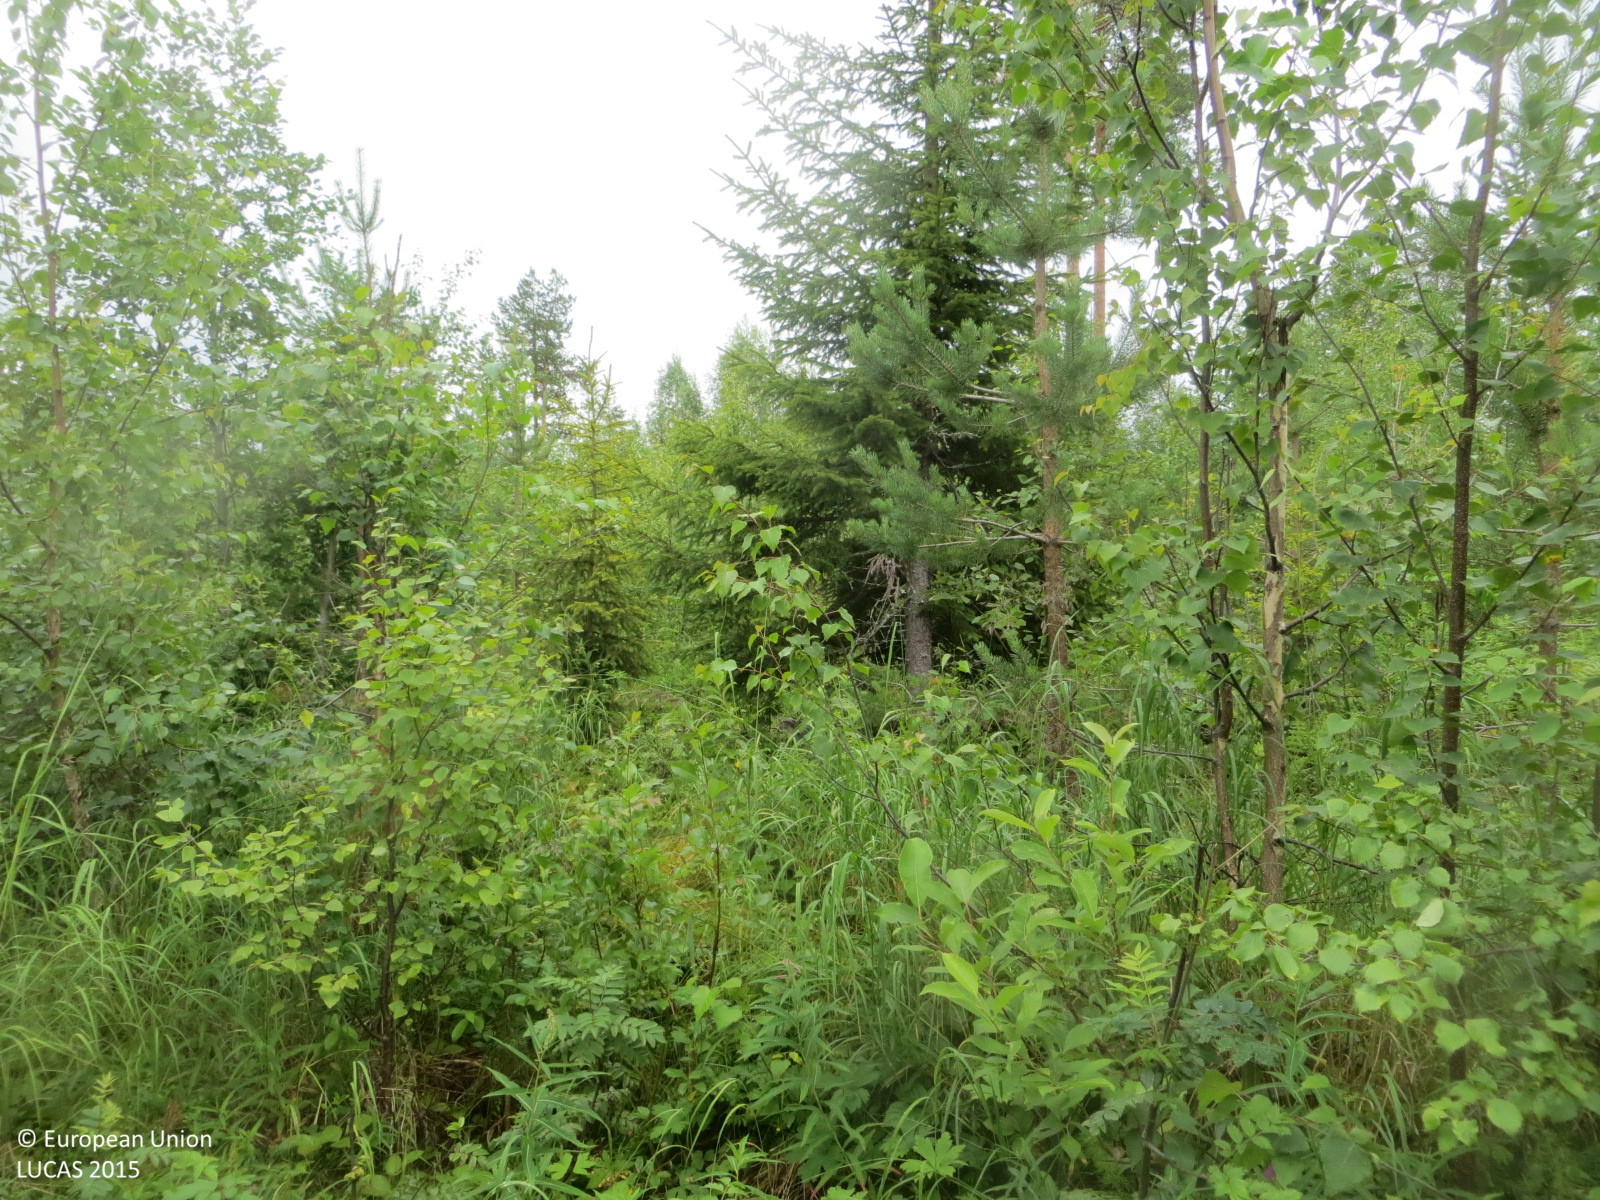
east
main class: Woodland
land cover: Other mixed woodland
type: boreal forest
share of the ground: > 75 %
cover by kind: broadleaved forest trees 50 %, coniferous forest trees 30 %, herbaceous plants 20 %
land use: Forestry
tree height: > 5 m
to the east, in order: Other mixed woodland; Ditches and canals; Abandoned hedges; Tracks; Ditches and canals; Spruce dominated mixed woodland; Pine dominated mixed woodland
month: July
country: FI
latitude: 66.1416
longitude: 24.7433
